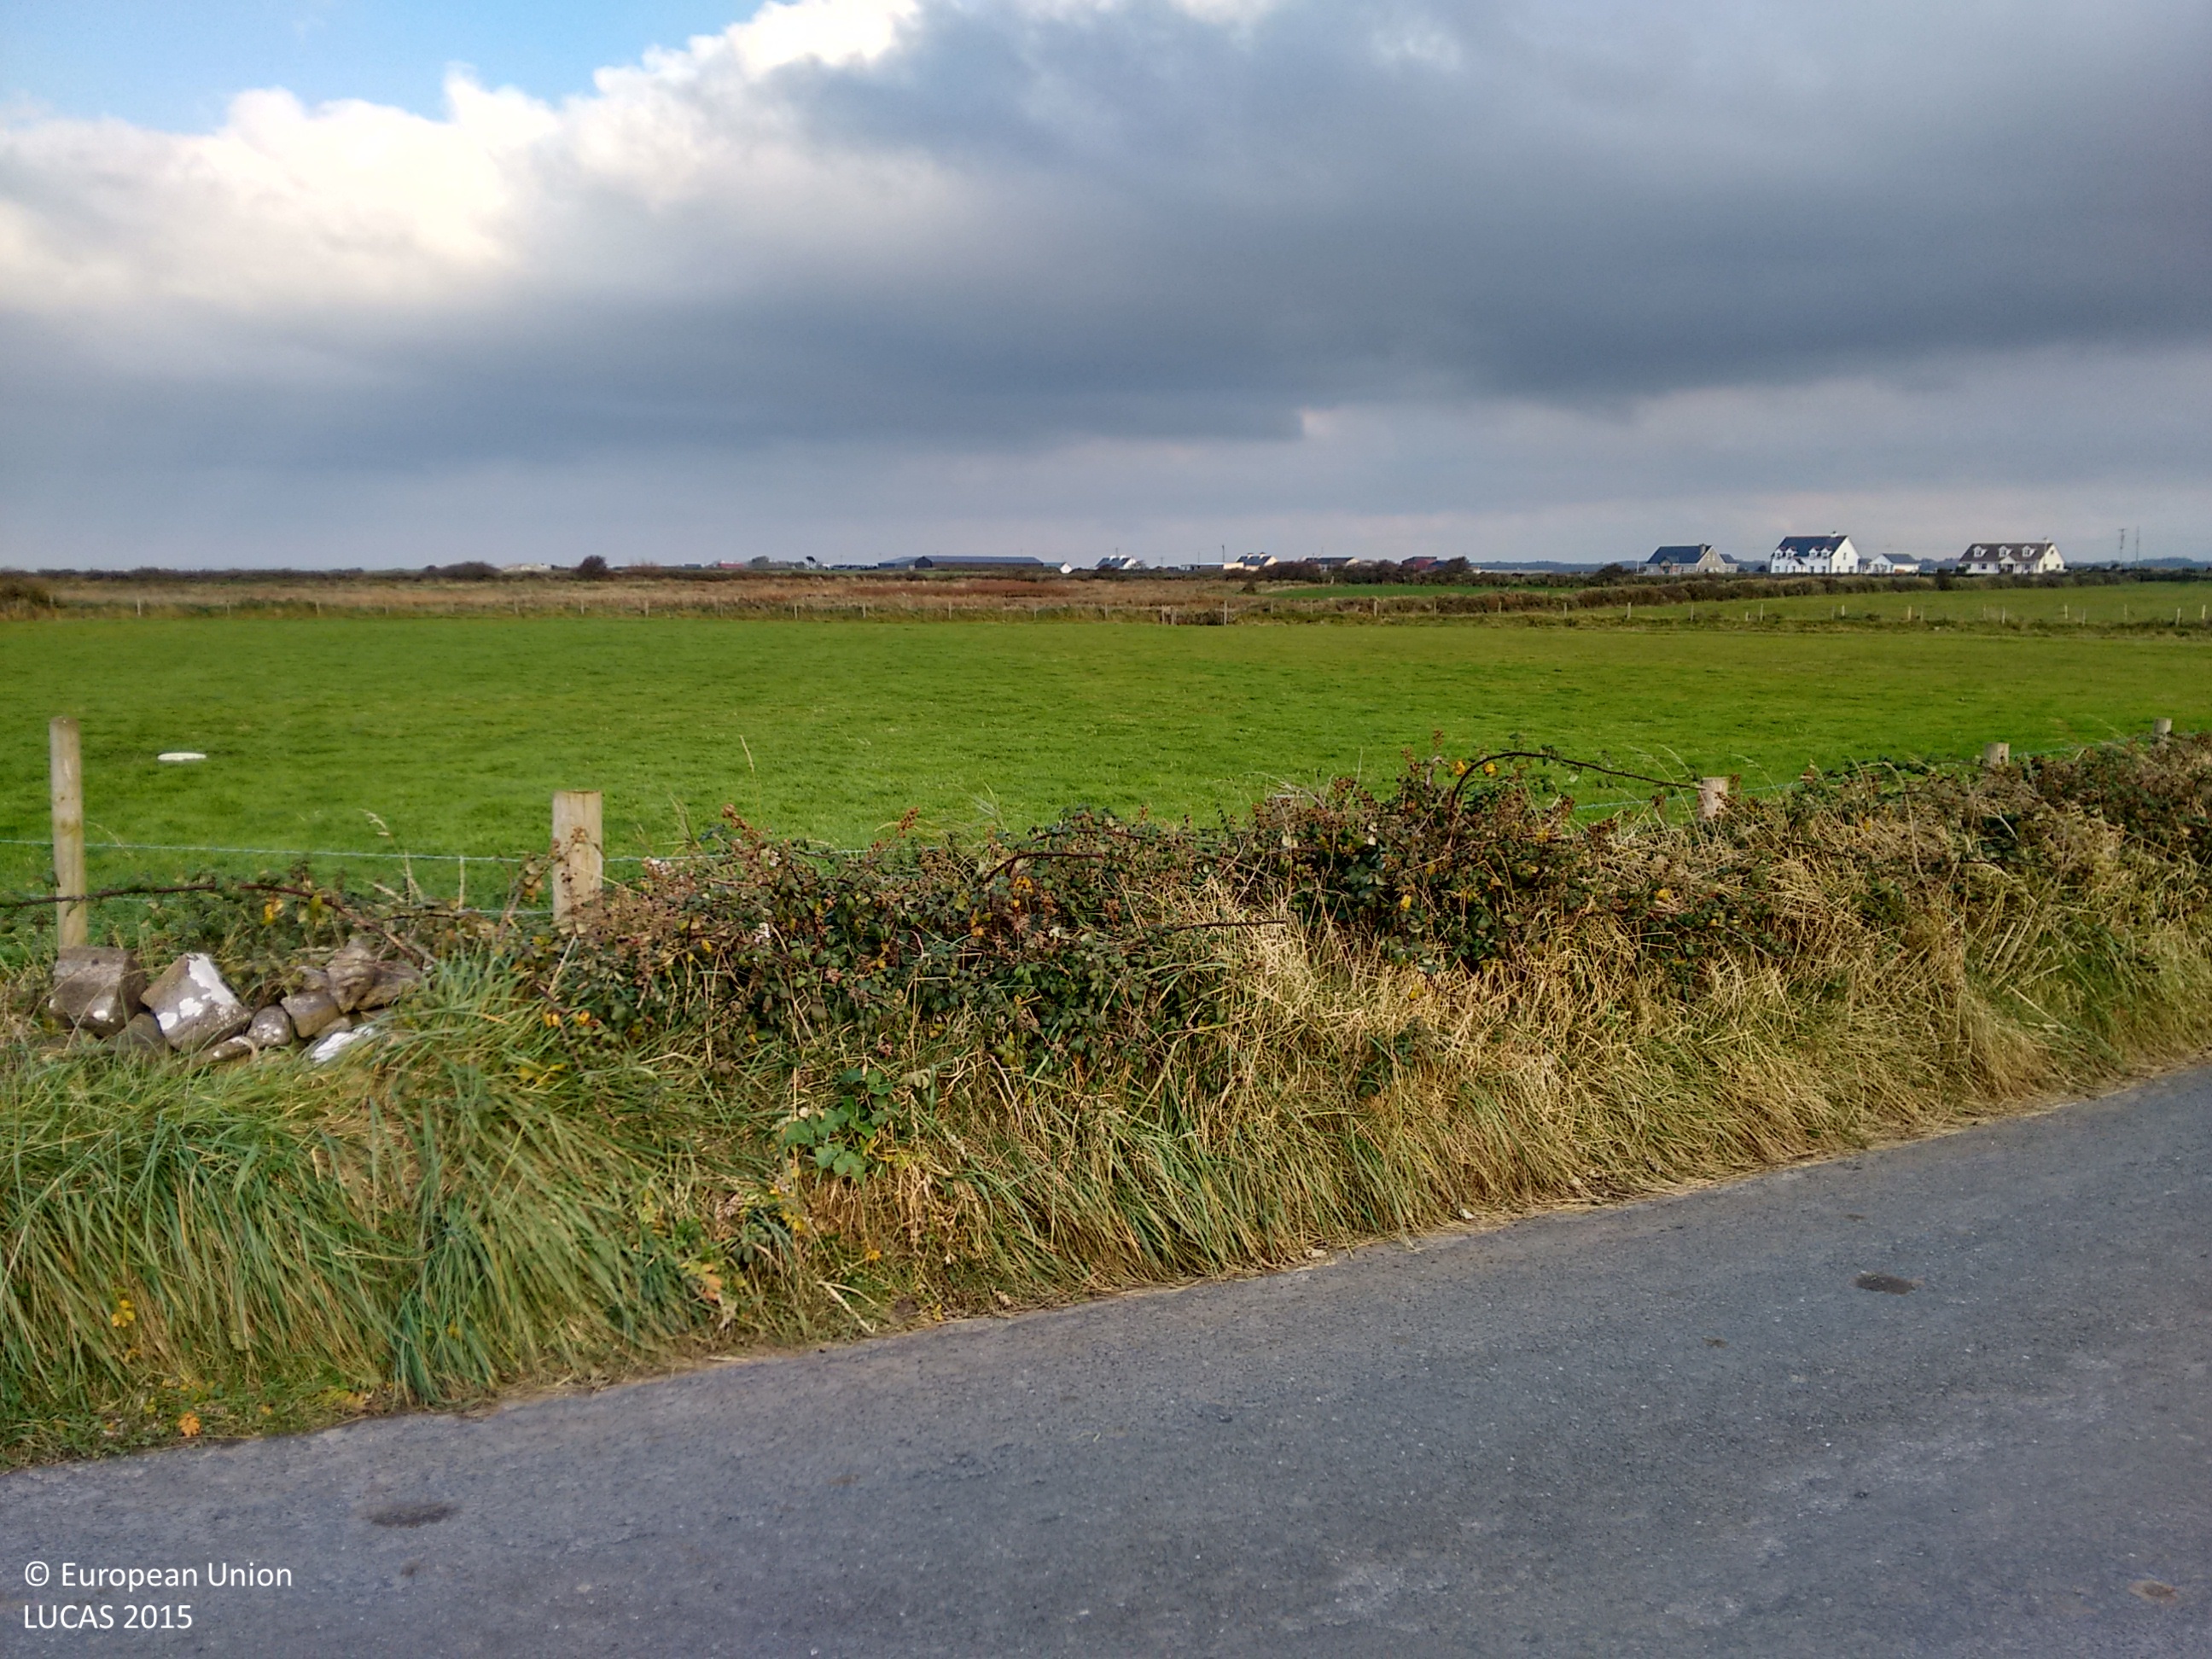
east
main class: Grassland
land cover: Grassland without tree/shrub cover
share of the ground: > 75 %
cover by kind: herbaceous plants 100 %
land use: Agriculture (excluding fallow land and kitchen gardens)
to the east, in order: Grassland without tree/shrub cover; Fences; Dry stone walls; Abandoned hedges; Grass margins; Paved roads, cycling and walking lanes; Grass margins; Abandoned hedges; Dry stone walls; Fences; Grassland without tree/shrub cover; Shruby margins; Fences; Abandoned hedges; Ditches and canals; Fences; Grassland without tree/shrub cover; Fences; Grassland without tree/shrub cover; Ditches and canals; Abandoned hedges; Fences; Shruby margins; Grassland without tree/shrub cover
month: November
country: IE
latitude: 54.2794
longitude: -9.0264
